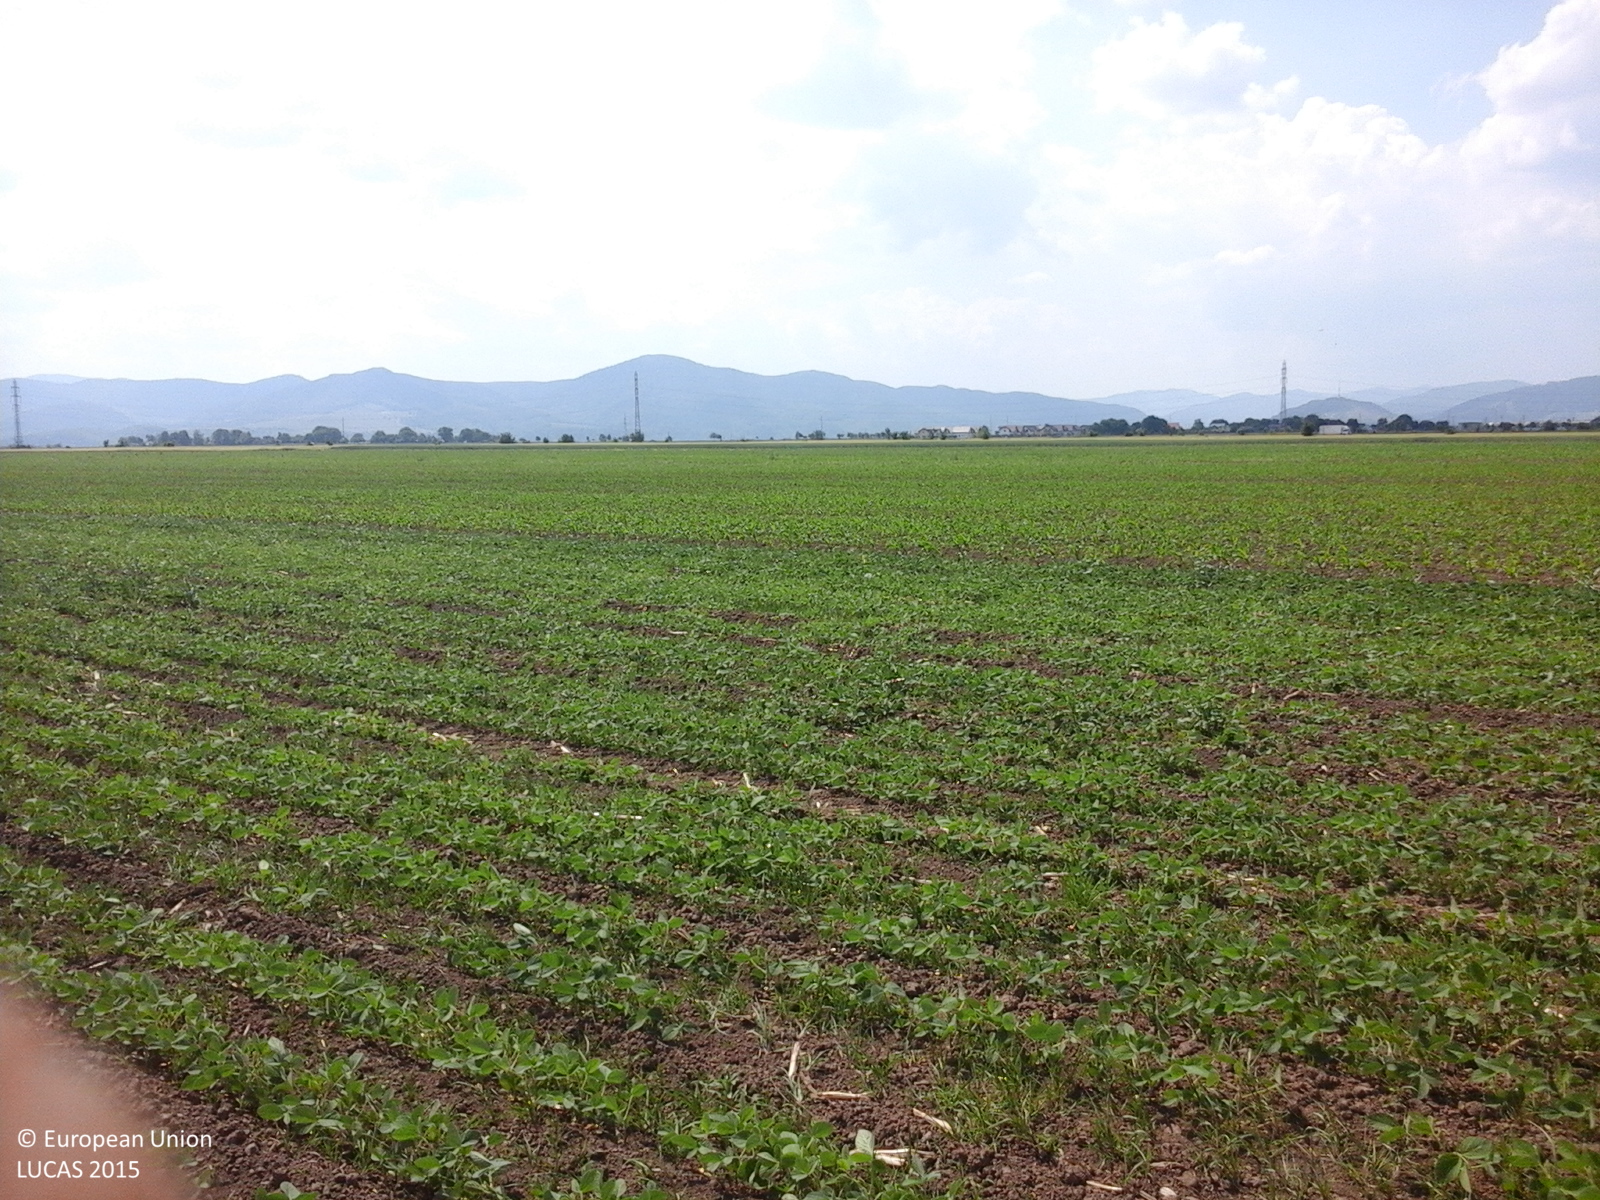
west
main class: Cropland
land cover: Dry pulses
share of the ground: > 75 %
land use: Agriculture (excluding fallow land and kitchen gardens)
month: June
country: RO
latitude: 46.8985
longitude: 26.4791
